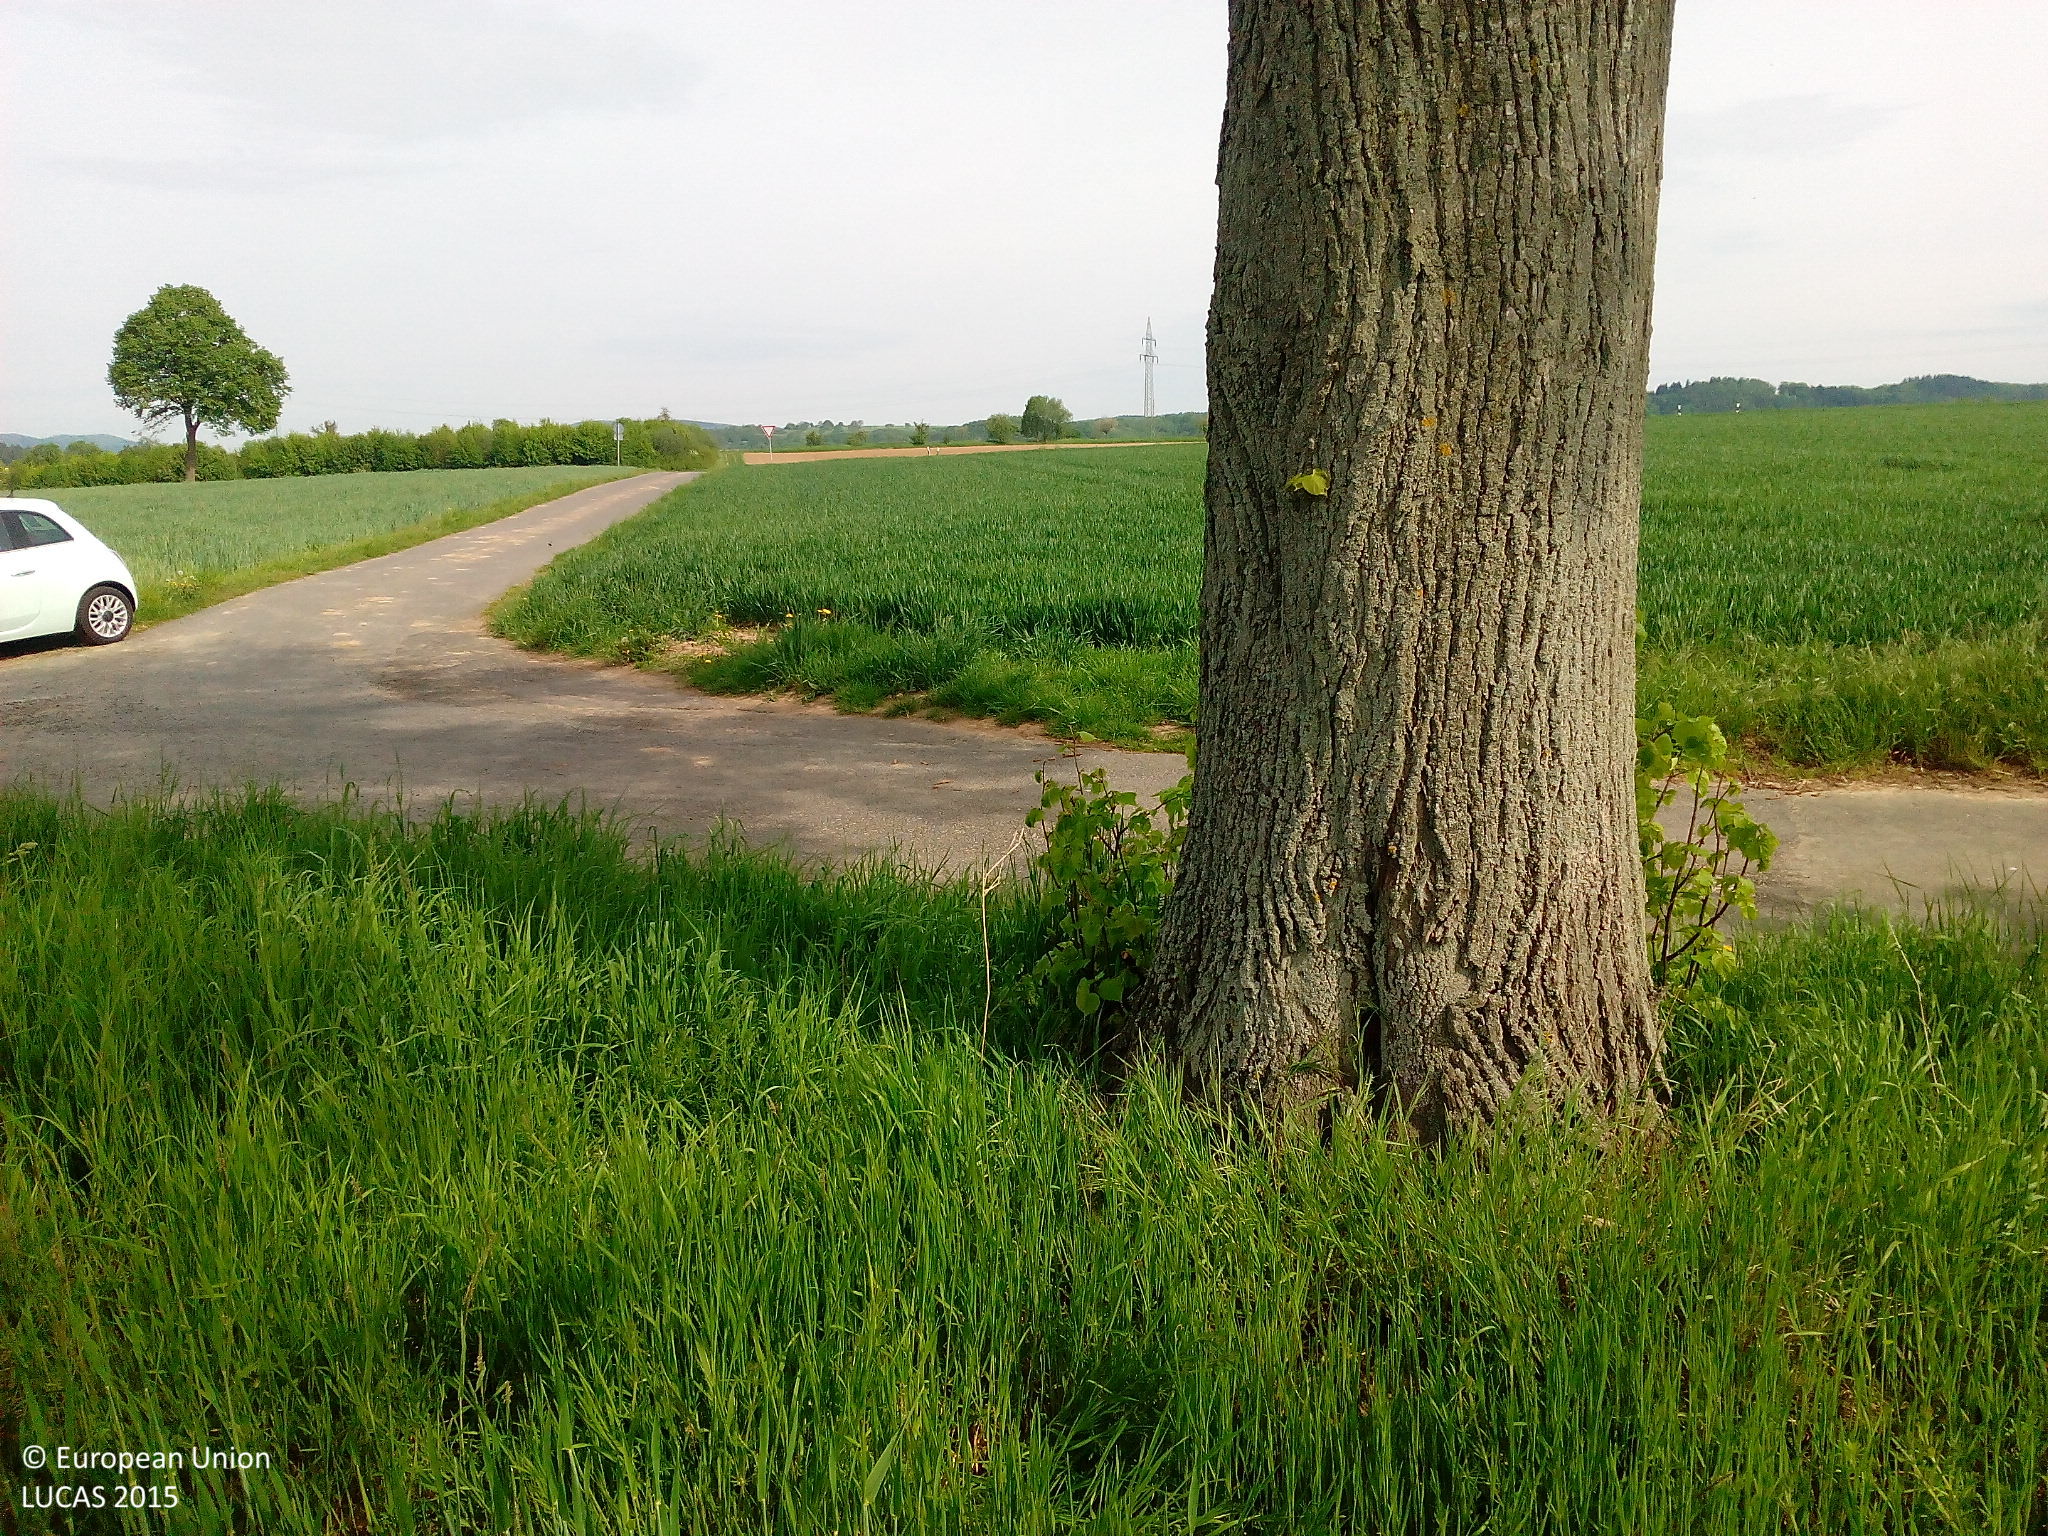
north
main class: Cropland
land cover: Barley
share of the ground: > 75 %
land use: Agriculture (excluding fallow land and kitchen gardens)
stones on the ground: < 10 %
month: May
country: DE
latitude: 51.2090
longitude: 9.9571
